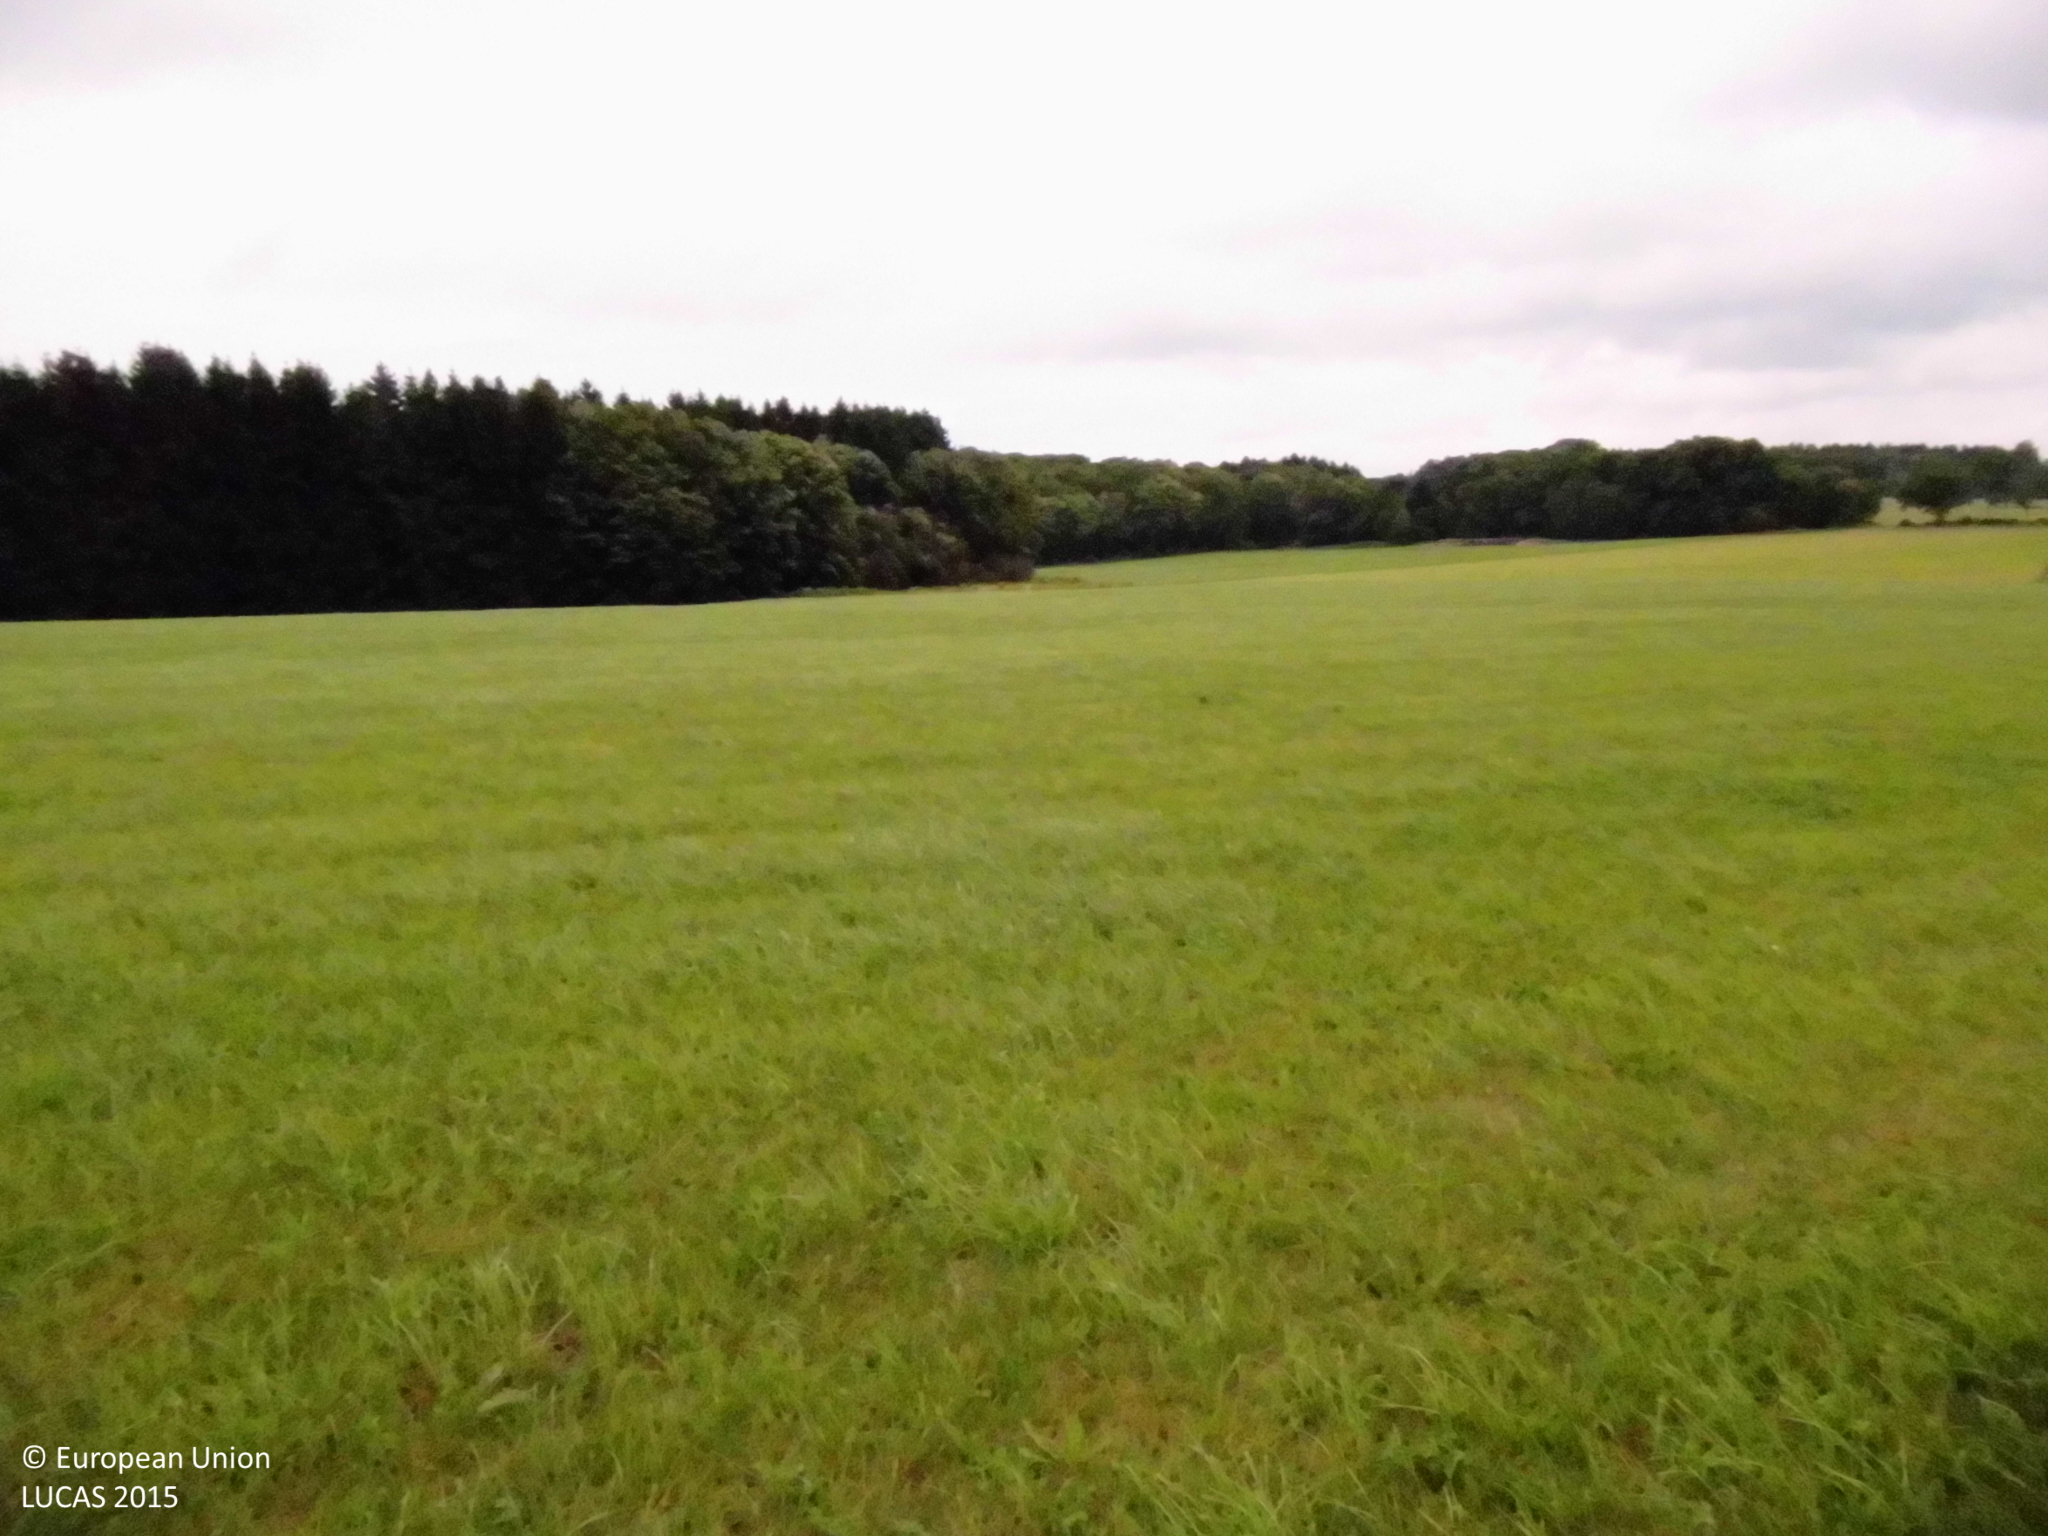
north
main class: Grassland
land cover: Grassland without tree/shrub cover
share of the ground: > 75 %
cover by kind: herbaceous plants 100 %
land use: Agriculture (excluding fallow land and kitchen gardens)
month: August
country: DE
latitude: 50.6704
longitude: 8.0053
